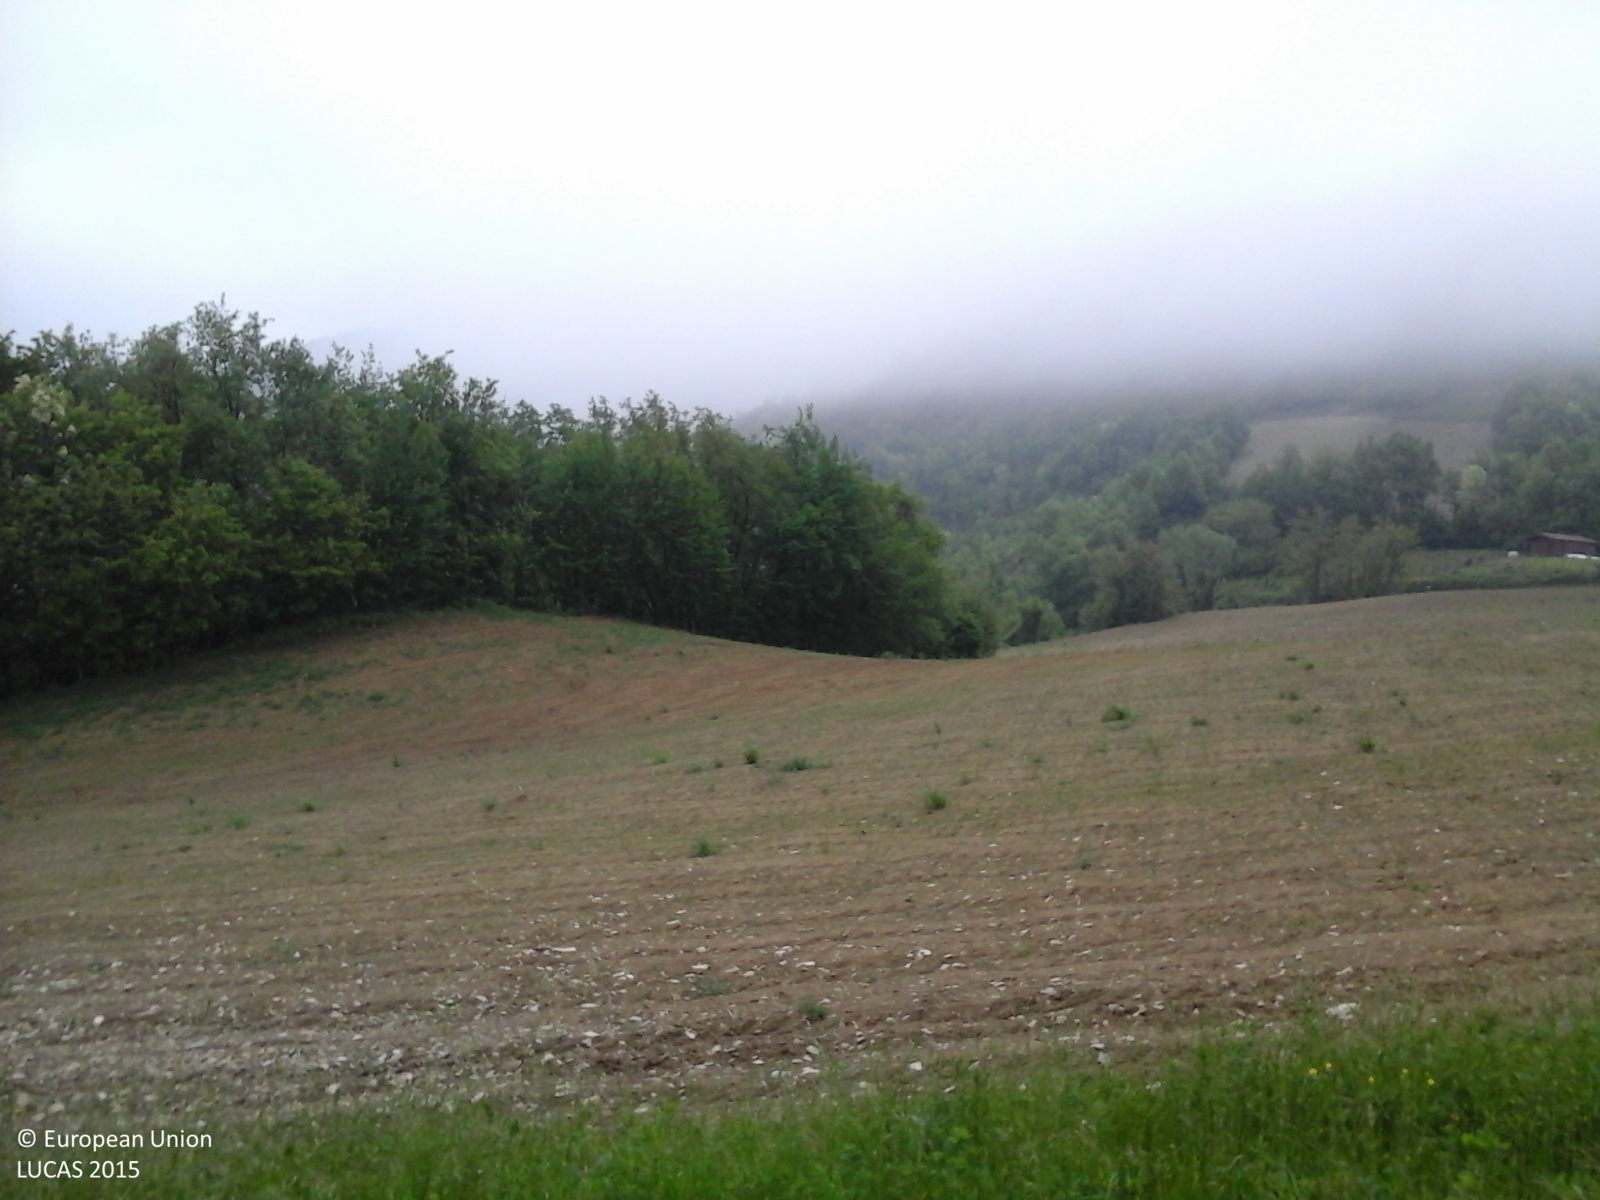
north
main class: Cropland
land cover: Other leguminous and mixtures for fodder
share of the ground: > 75 %
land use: Agriculture (excluding fallow land and kitchen gardens)
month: April
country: IT
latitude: 44.8897
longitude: 9.3808
